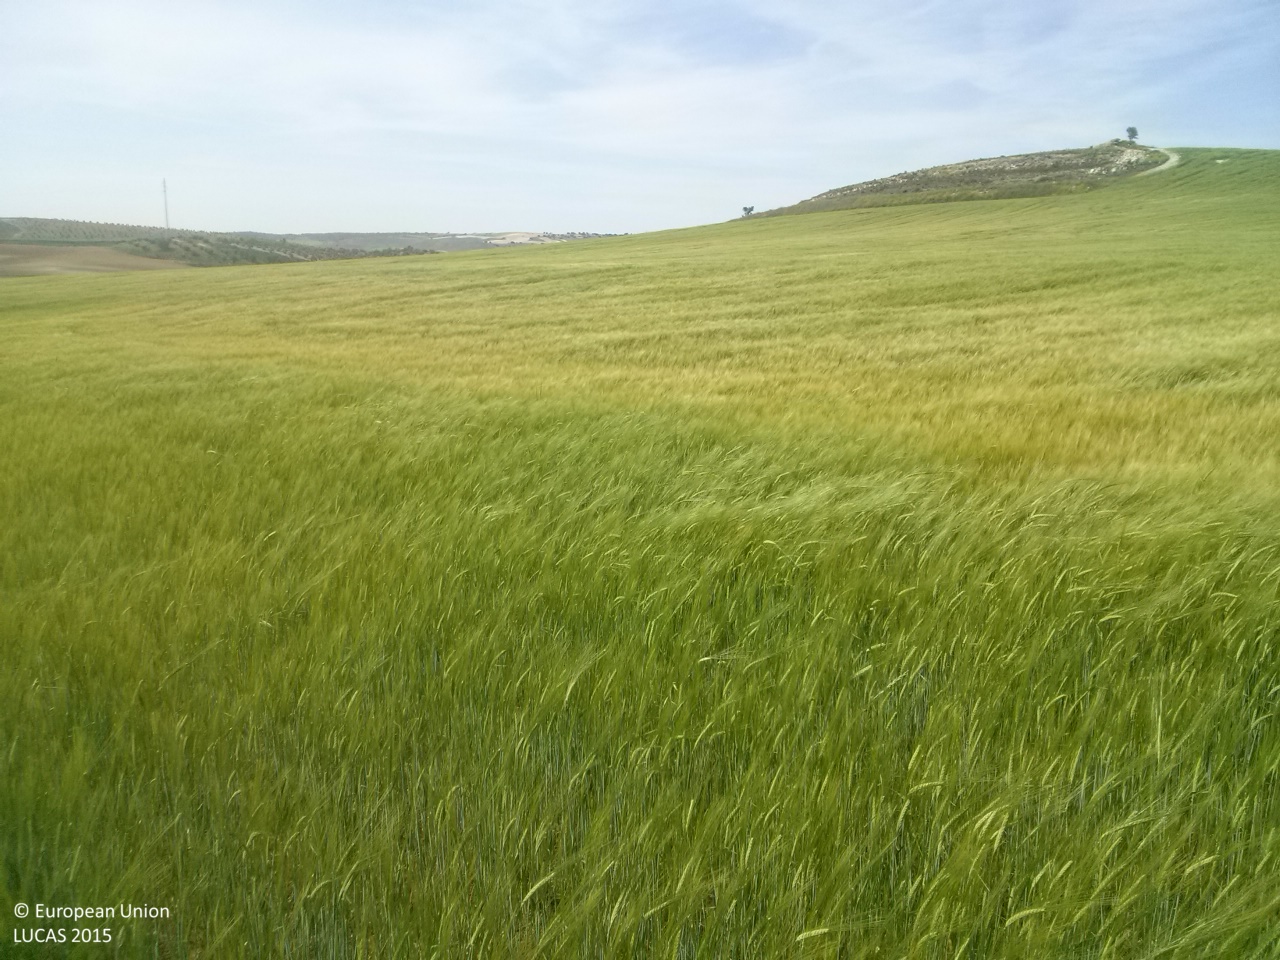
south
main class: Cropland
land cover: Barley
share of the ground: > 75 %
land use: Agriculture (excluding fallow land and kitchen gardens)
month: May
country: ES
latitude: 39.7906
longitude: -2.6643
